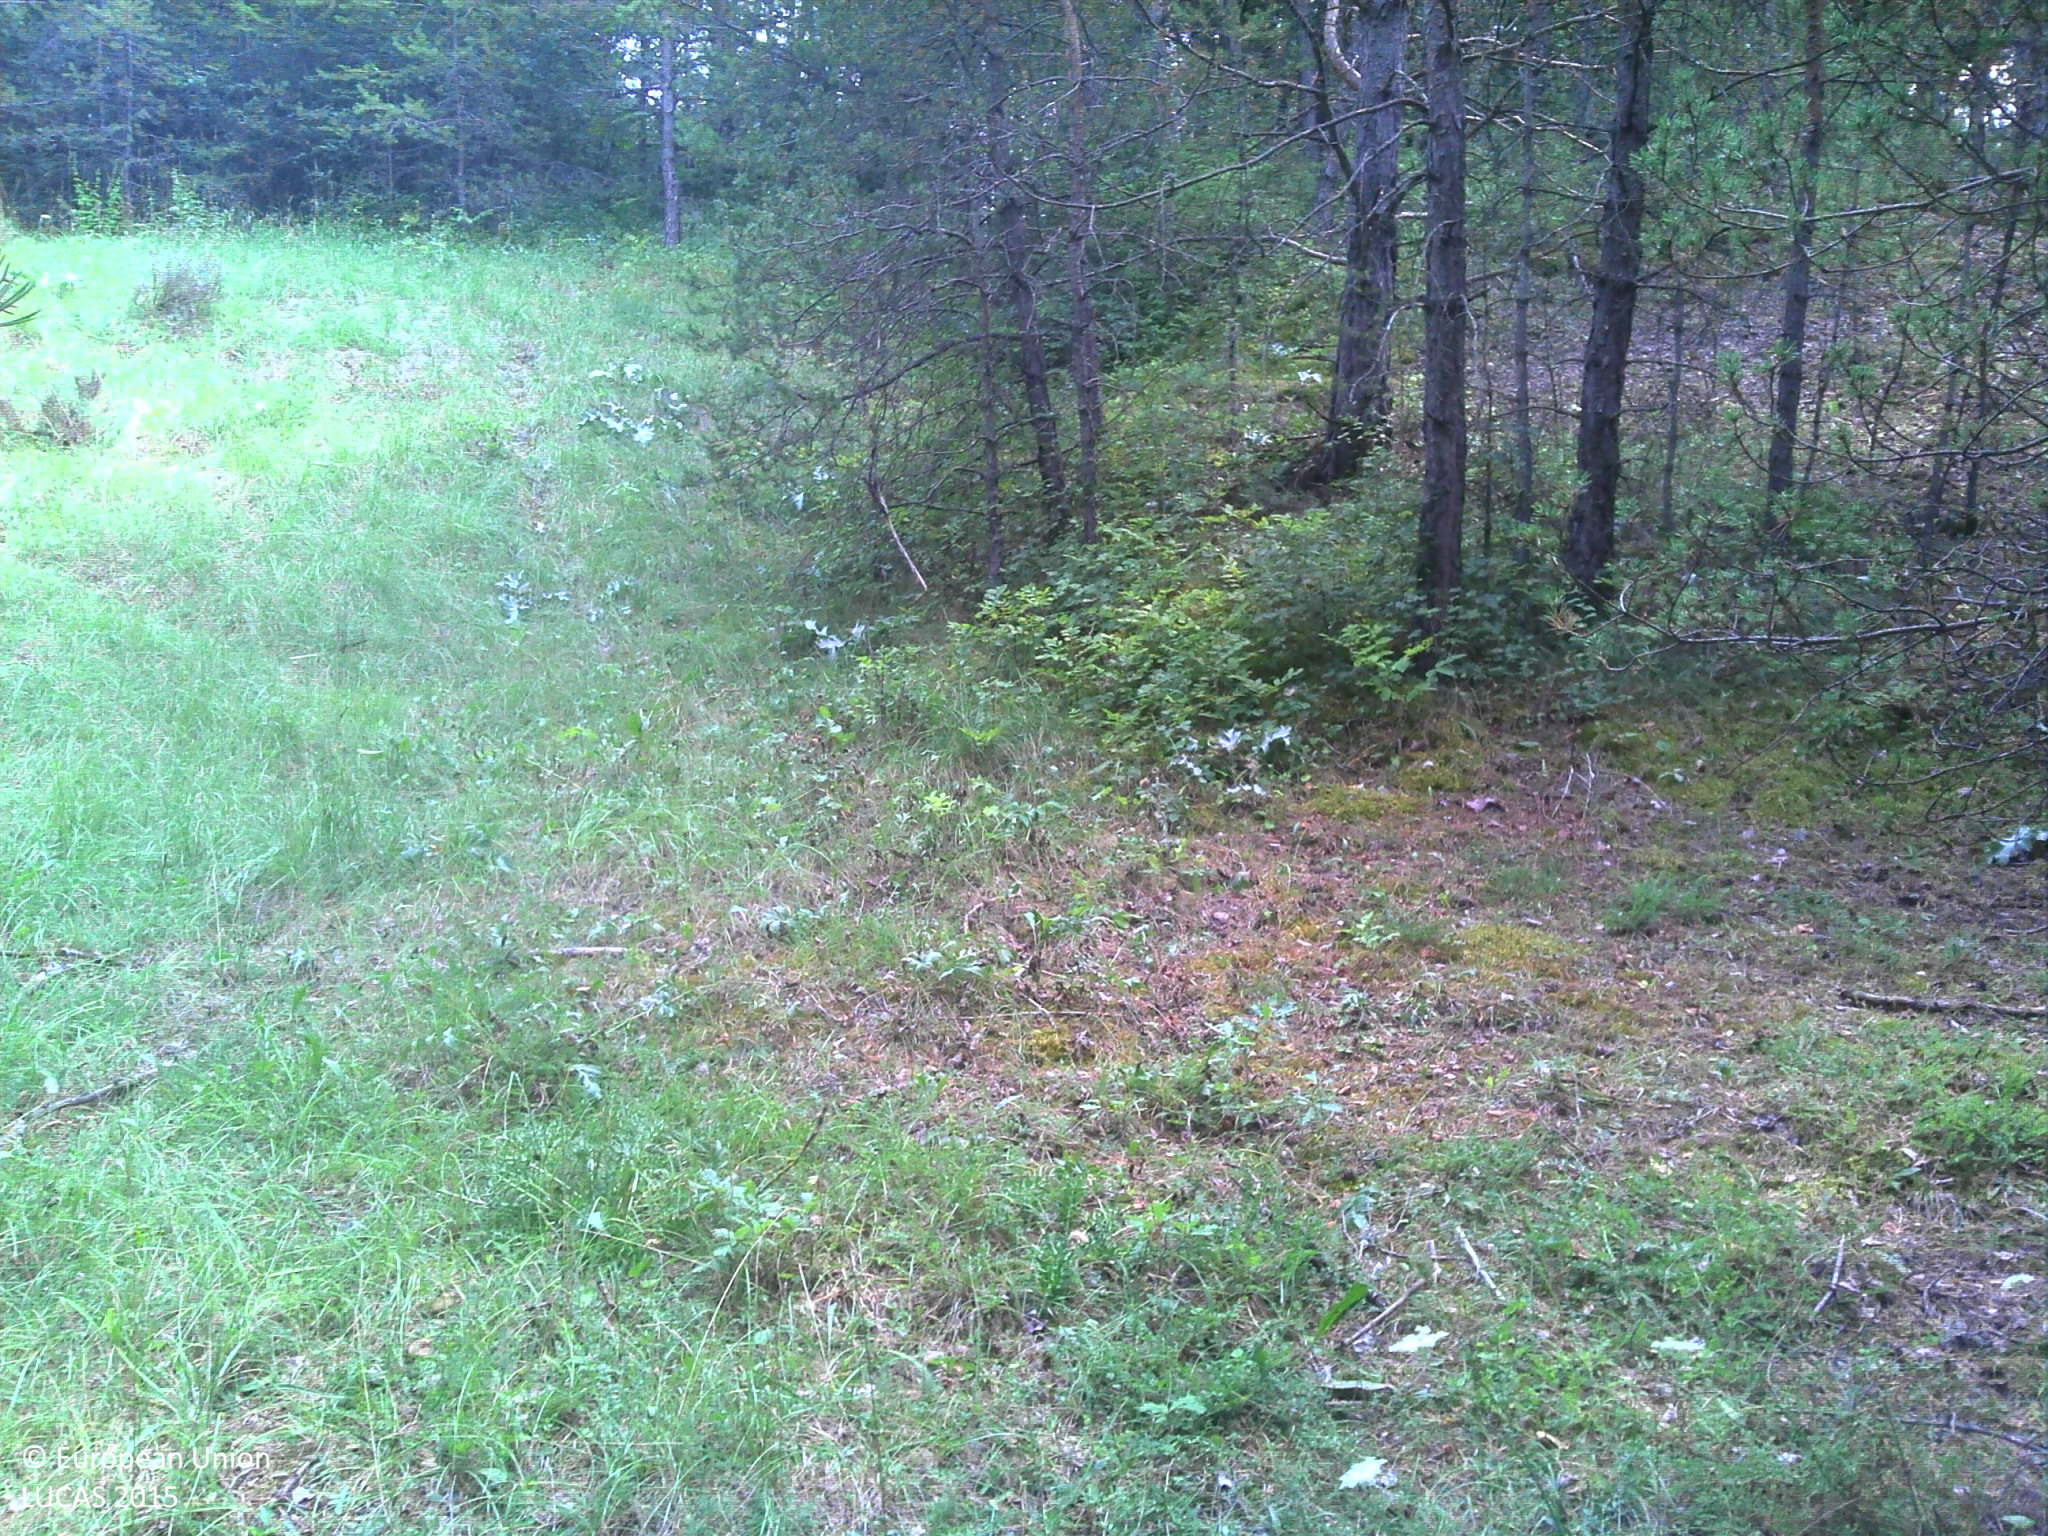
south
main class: Woodland
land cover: Pine dominated coniferous woodland
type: coniferous forest of the mediterranean region
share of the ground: > 75 %
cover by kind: coniferous forest trees 80 %, herbaceous plants 10 %, consolidated bare surface 10 %
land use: Forestry
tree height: > 5 m
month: August
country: FR
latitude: 43.9831
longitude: 6.4543
